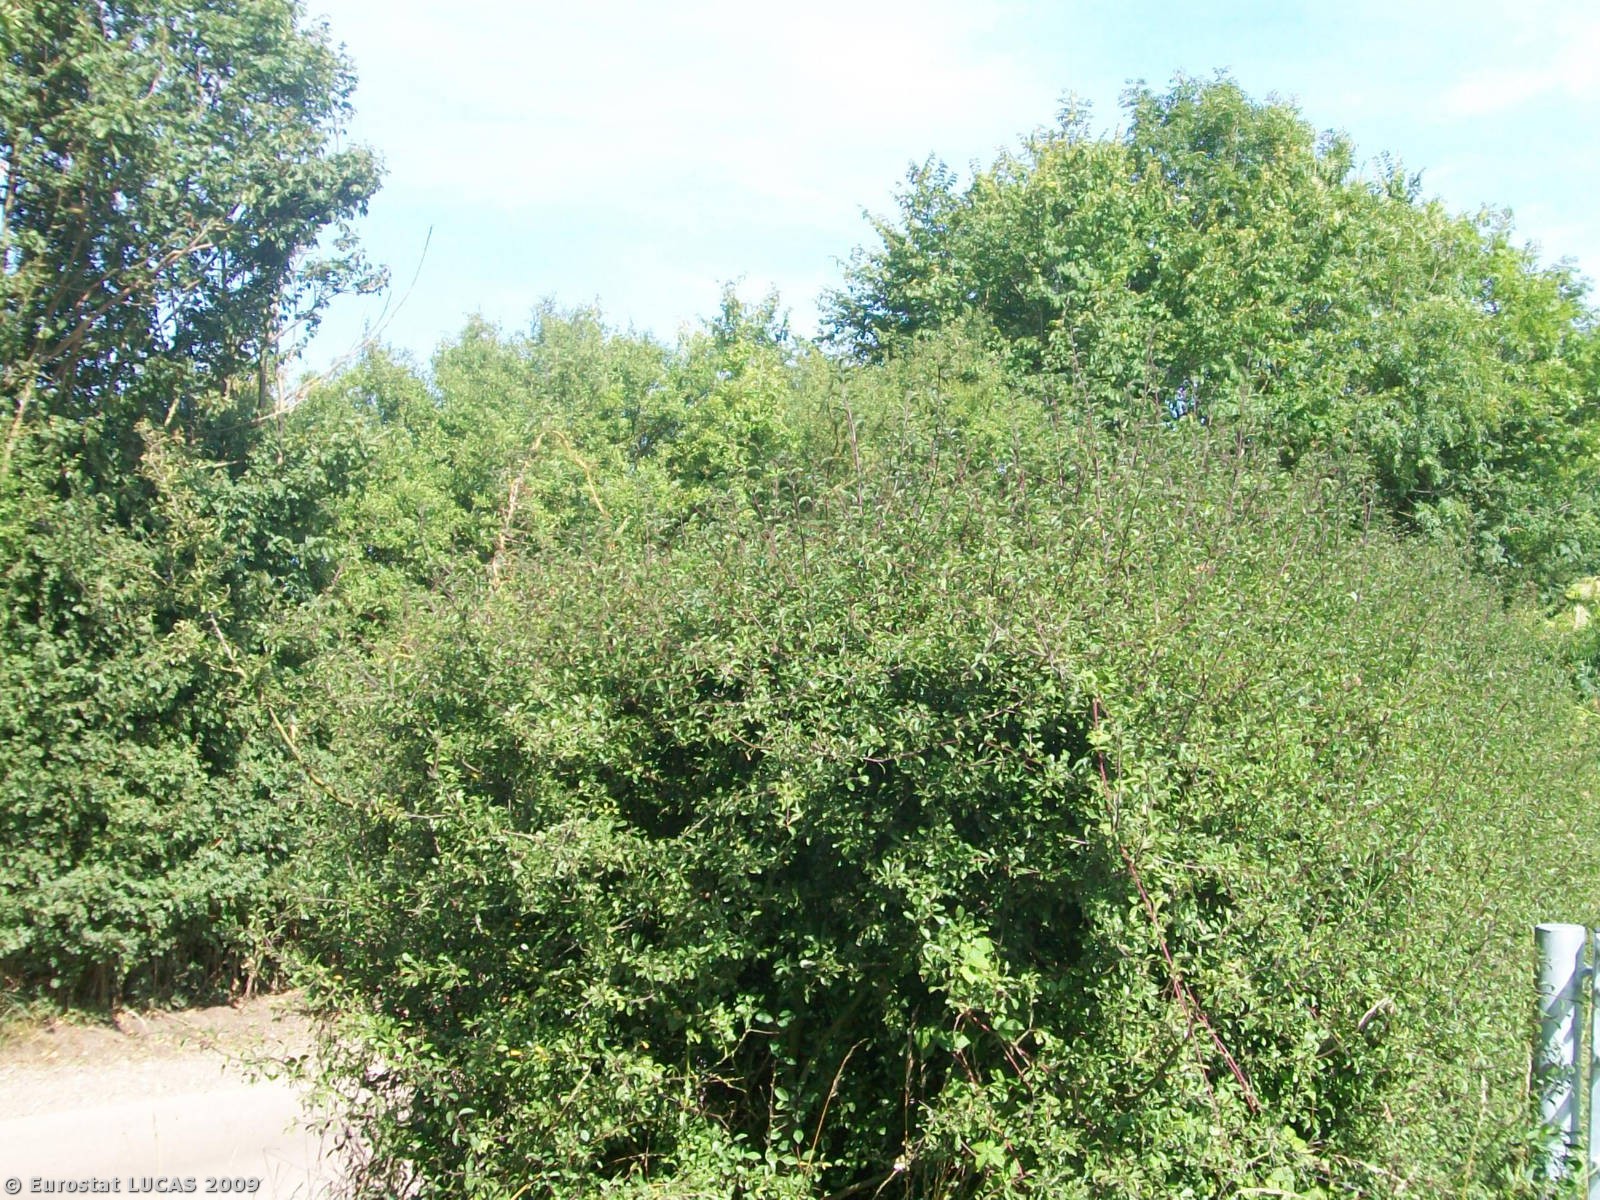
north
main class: Cropland
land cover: Lucerne
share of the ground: > 75 %
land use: Agriculture (excluding fallow land and kitchen gardens)
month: August
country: GB
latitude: 51.8880
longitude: 0.0734
